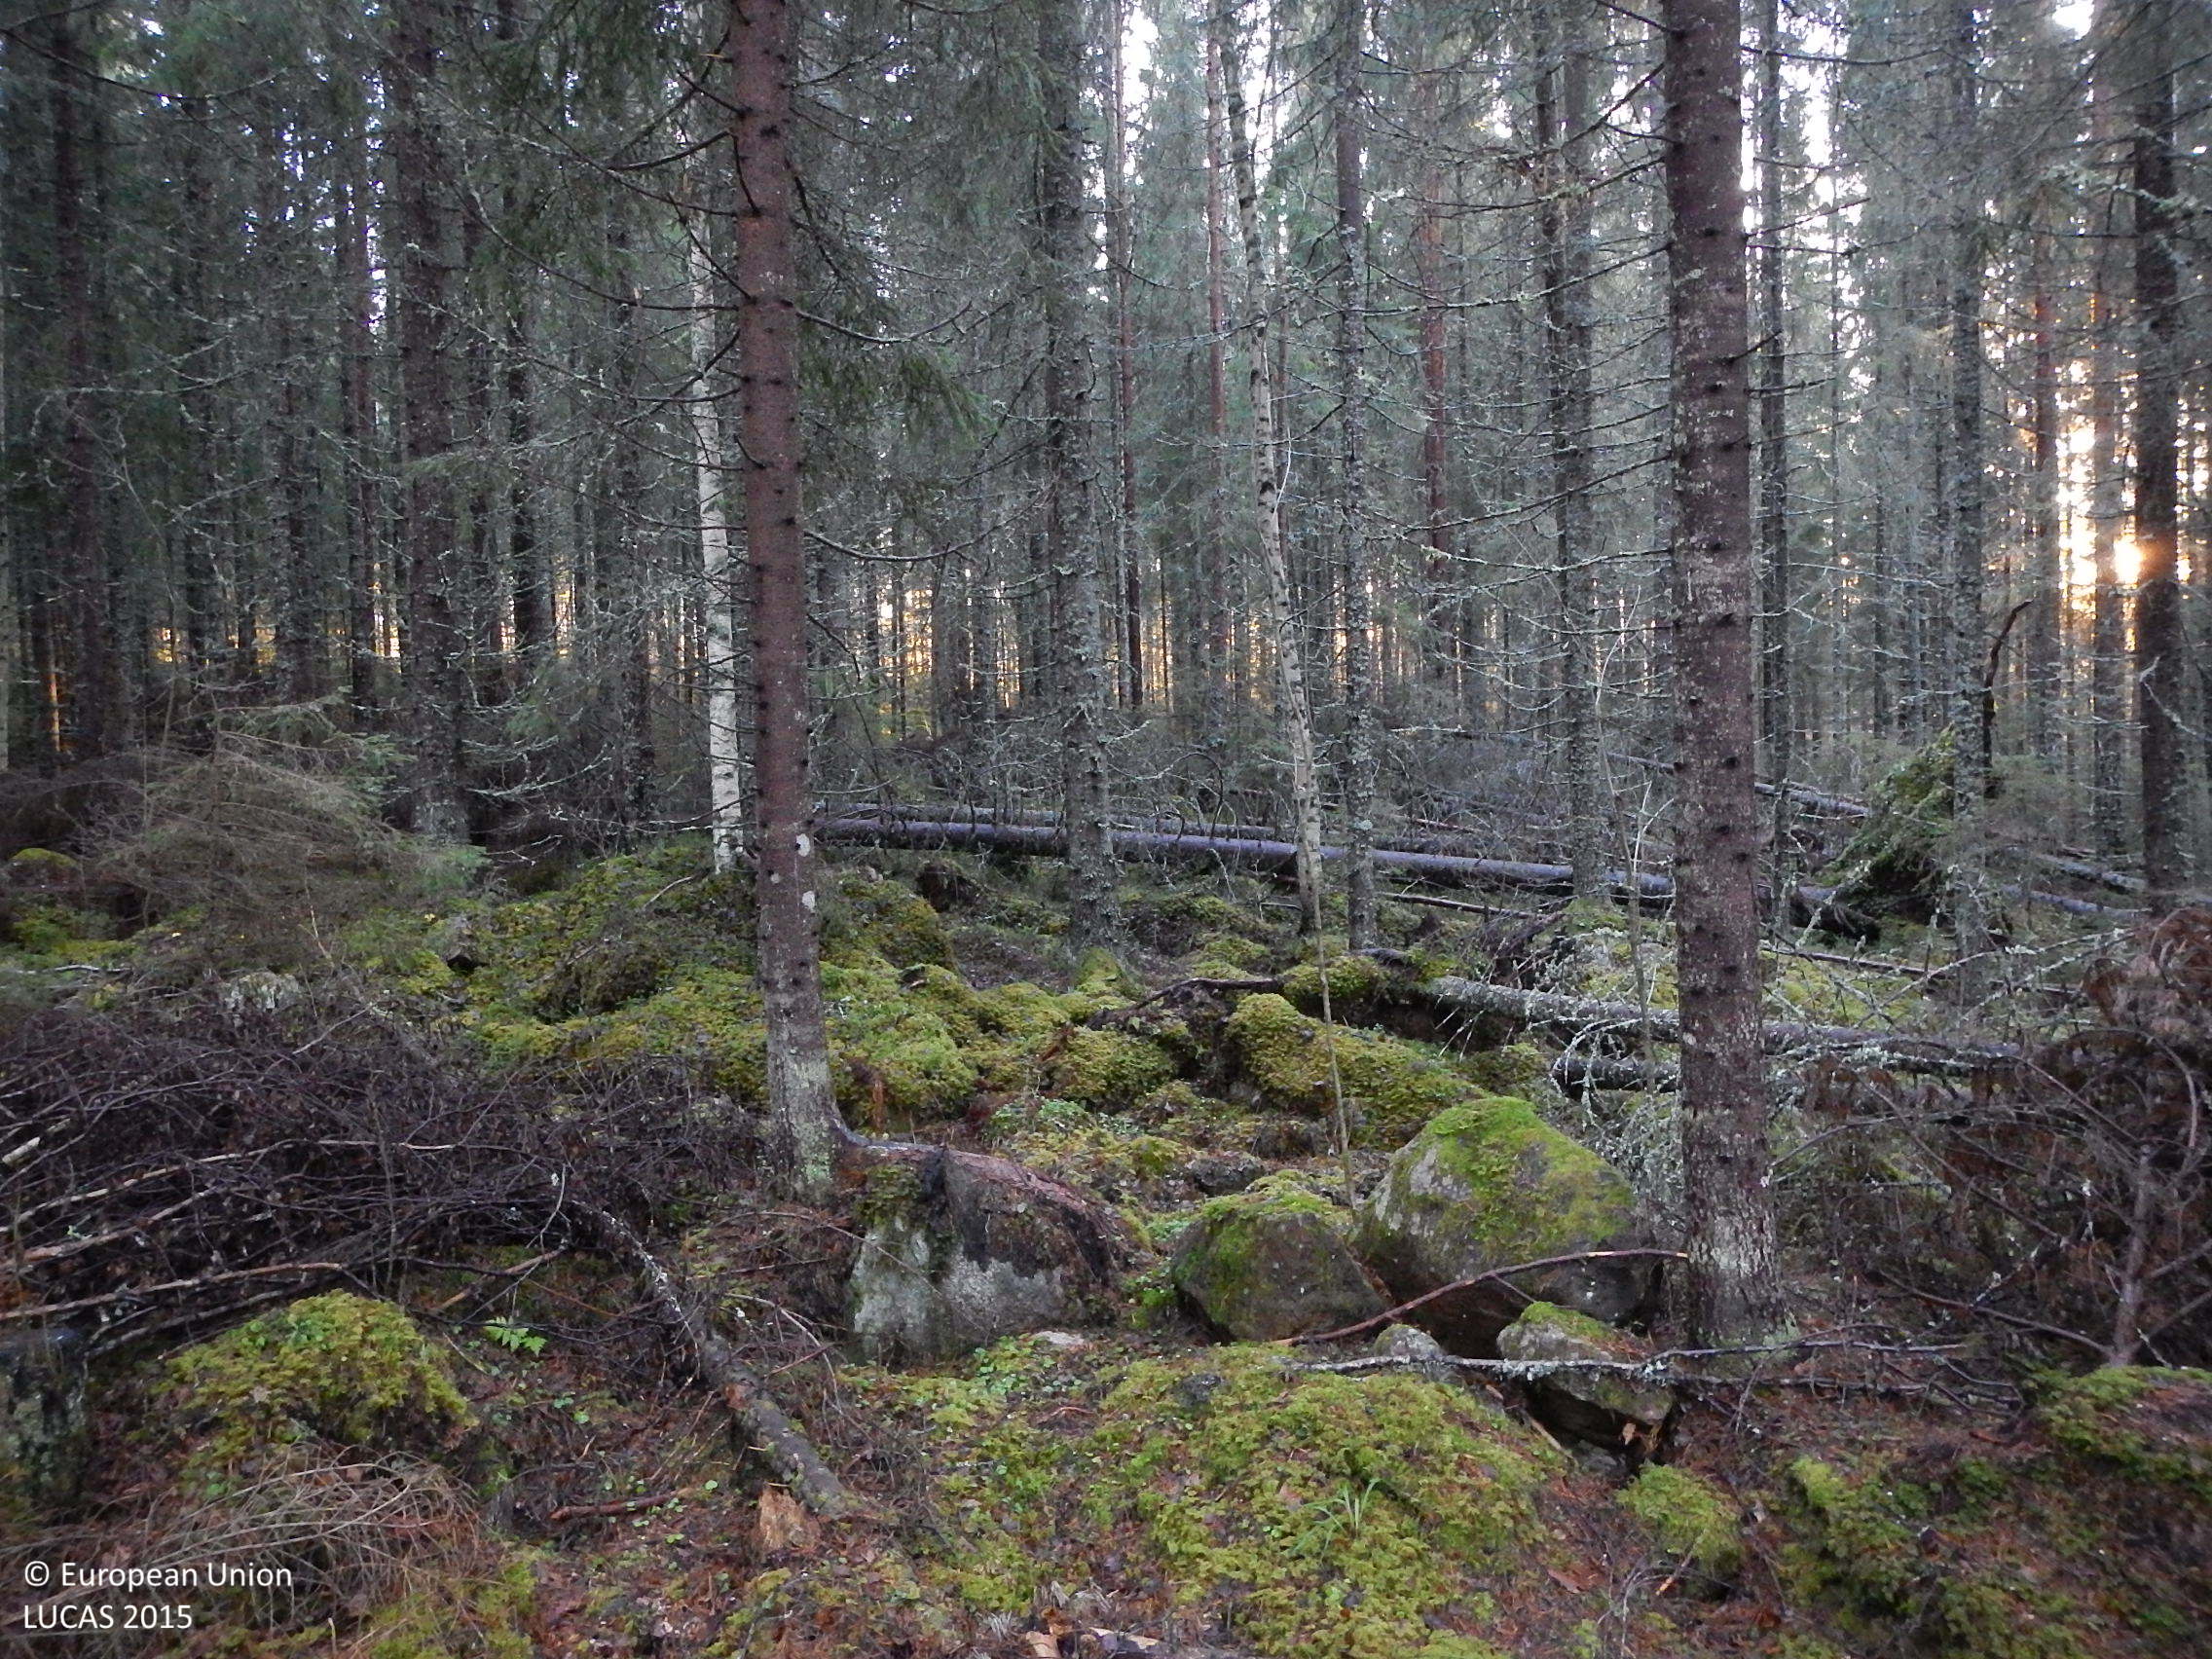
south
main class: Woodland
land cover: Spruce dominated coniferous woodland
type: boreal forest
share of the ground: > 75 %
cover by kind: coniferous forest trees 80 %, lichens and mosses 15 %, broadleaved forest trees 5 %
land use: Forestry
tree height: > 5 m
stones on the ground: < 10 %
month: November
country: SE
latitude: 61.8813
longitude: 16.3539
